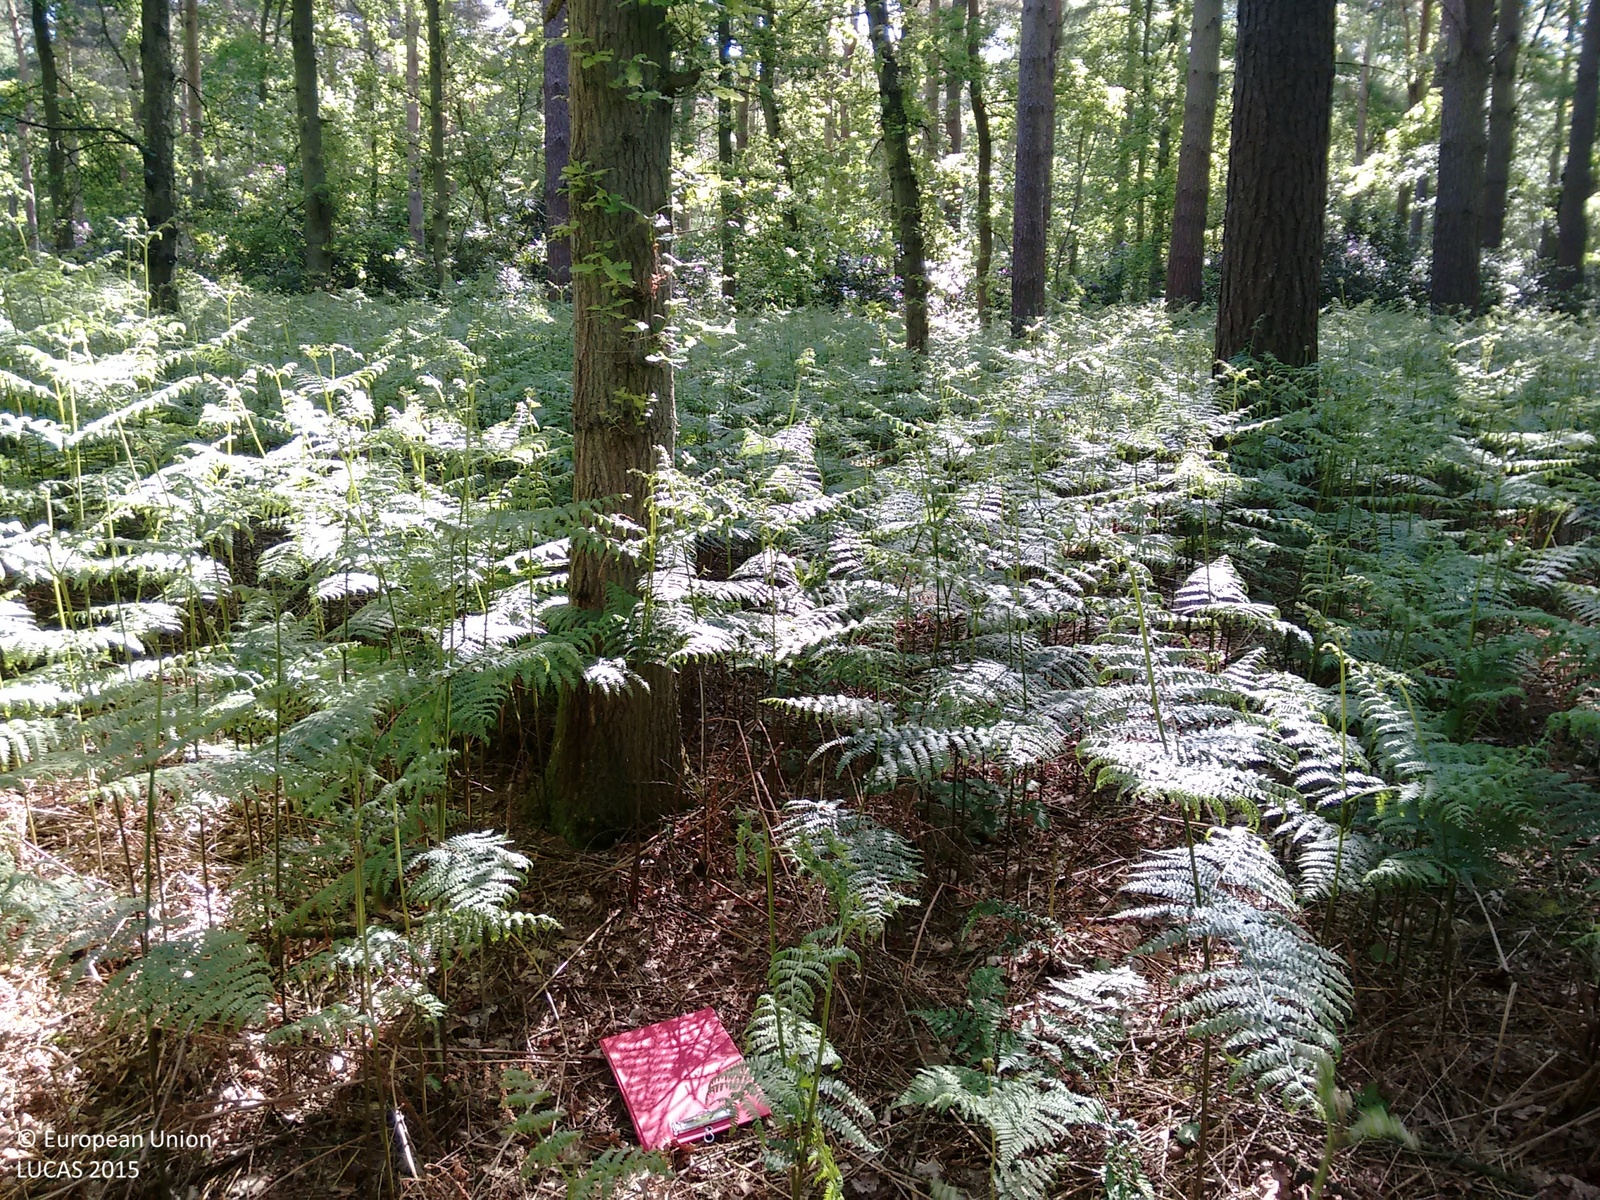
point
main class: Woodland
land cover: Other mixed woodland
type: mesophytic deciduous forest
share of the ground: > 75 %
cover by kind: broadleaved forest trees 65 %, coniferous forest trees 35 %
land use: Forestry
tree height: > 5 m
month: June
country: GB
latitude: 53.9575
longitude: -0.9386
